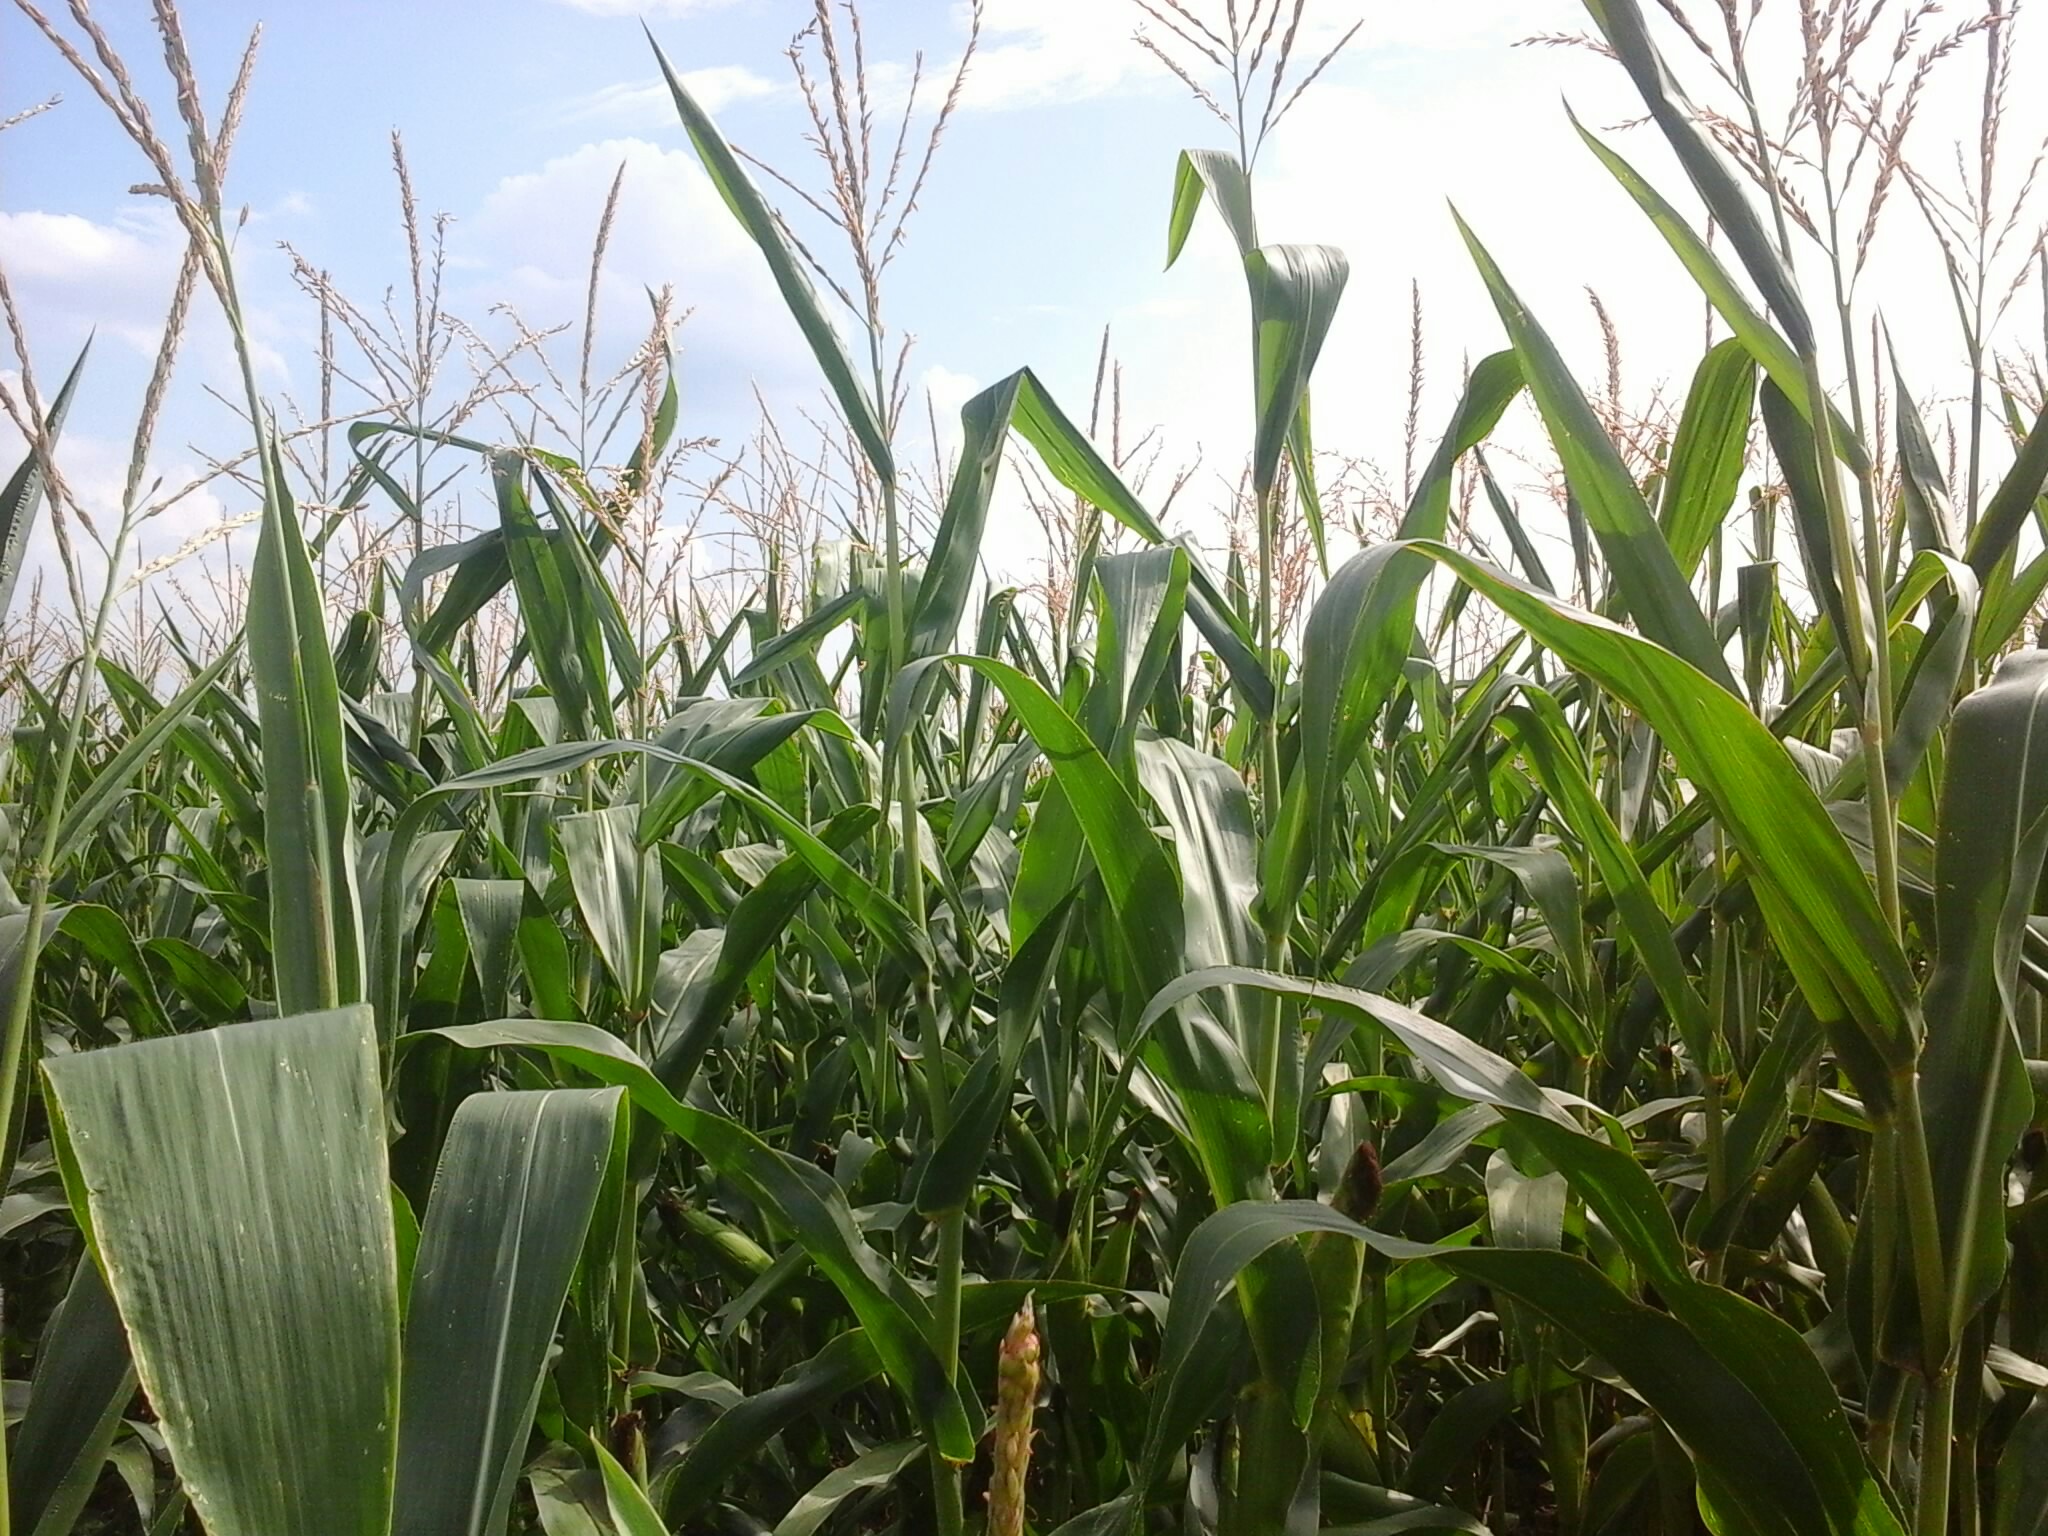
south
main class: Cropland
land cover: Maize
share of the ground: > 75 %
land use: Agriculture (excluding fallow land and kitchen gardens)
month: August
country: HU
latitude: 47.5372
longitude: 18.2087
